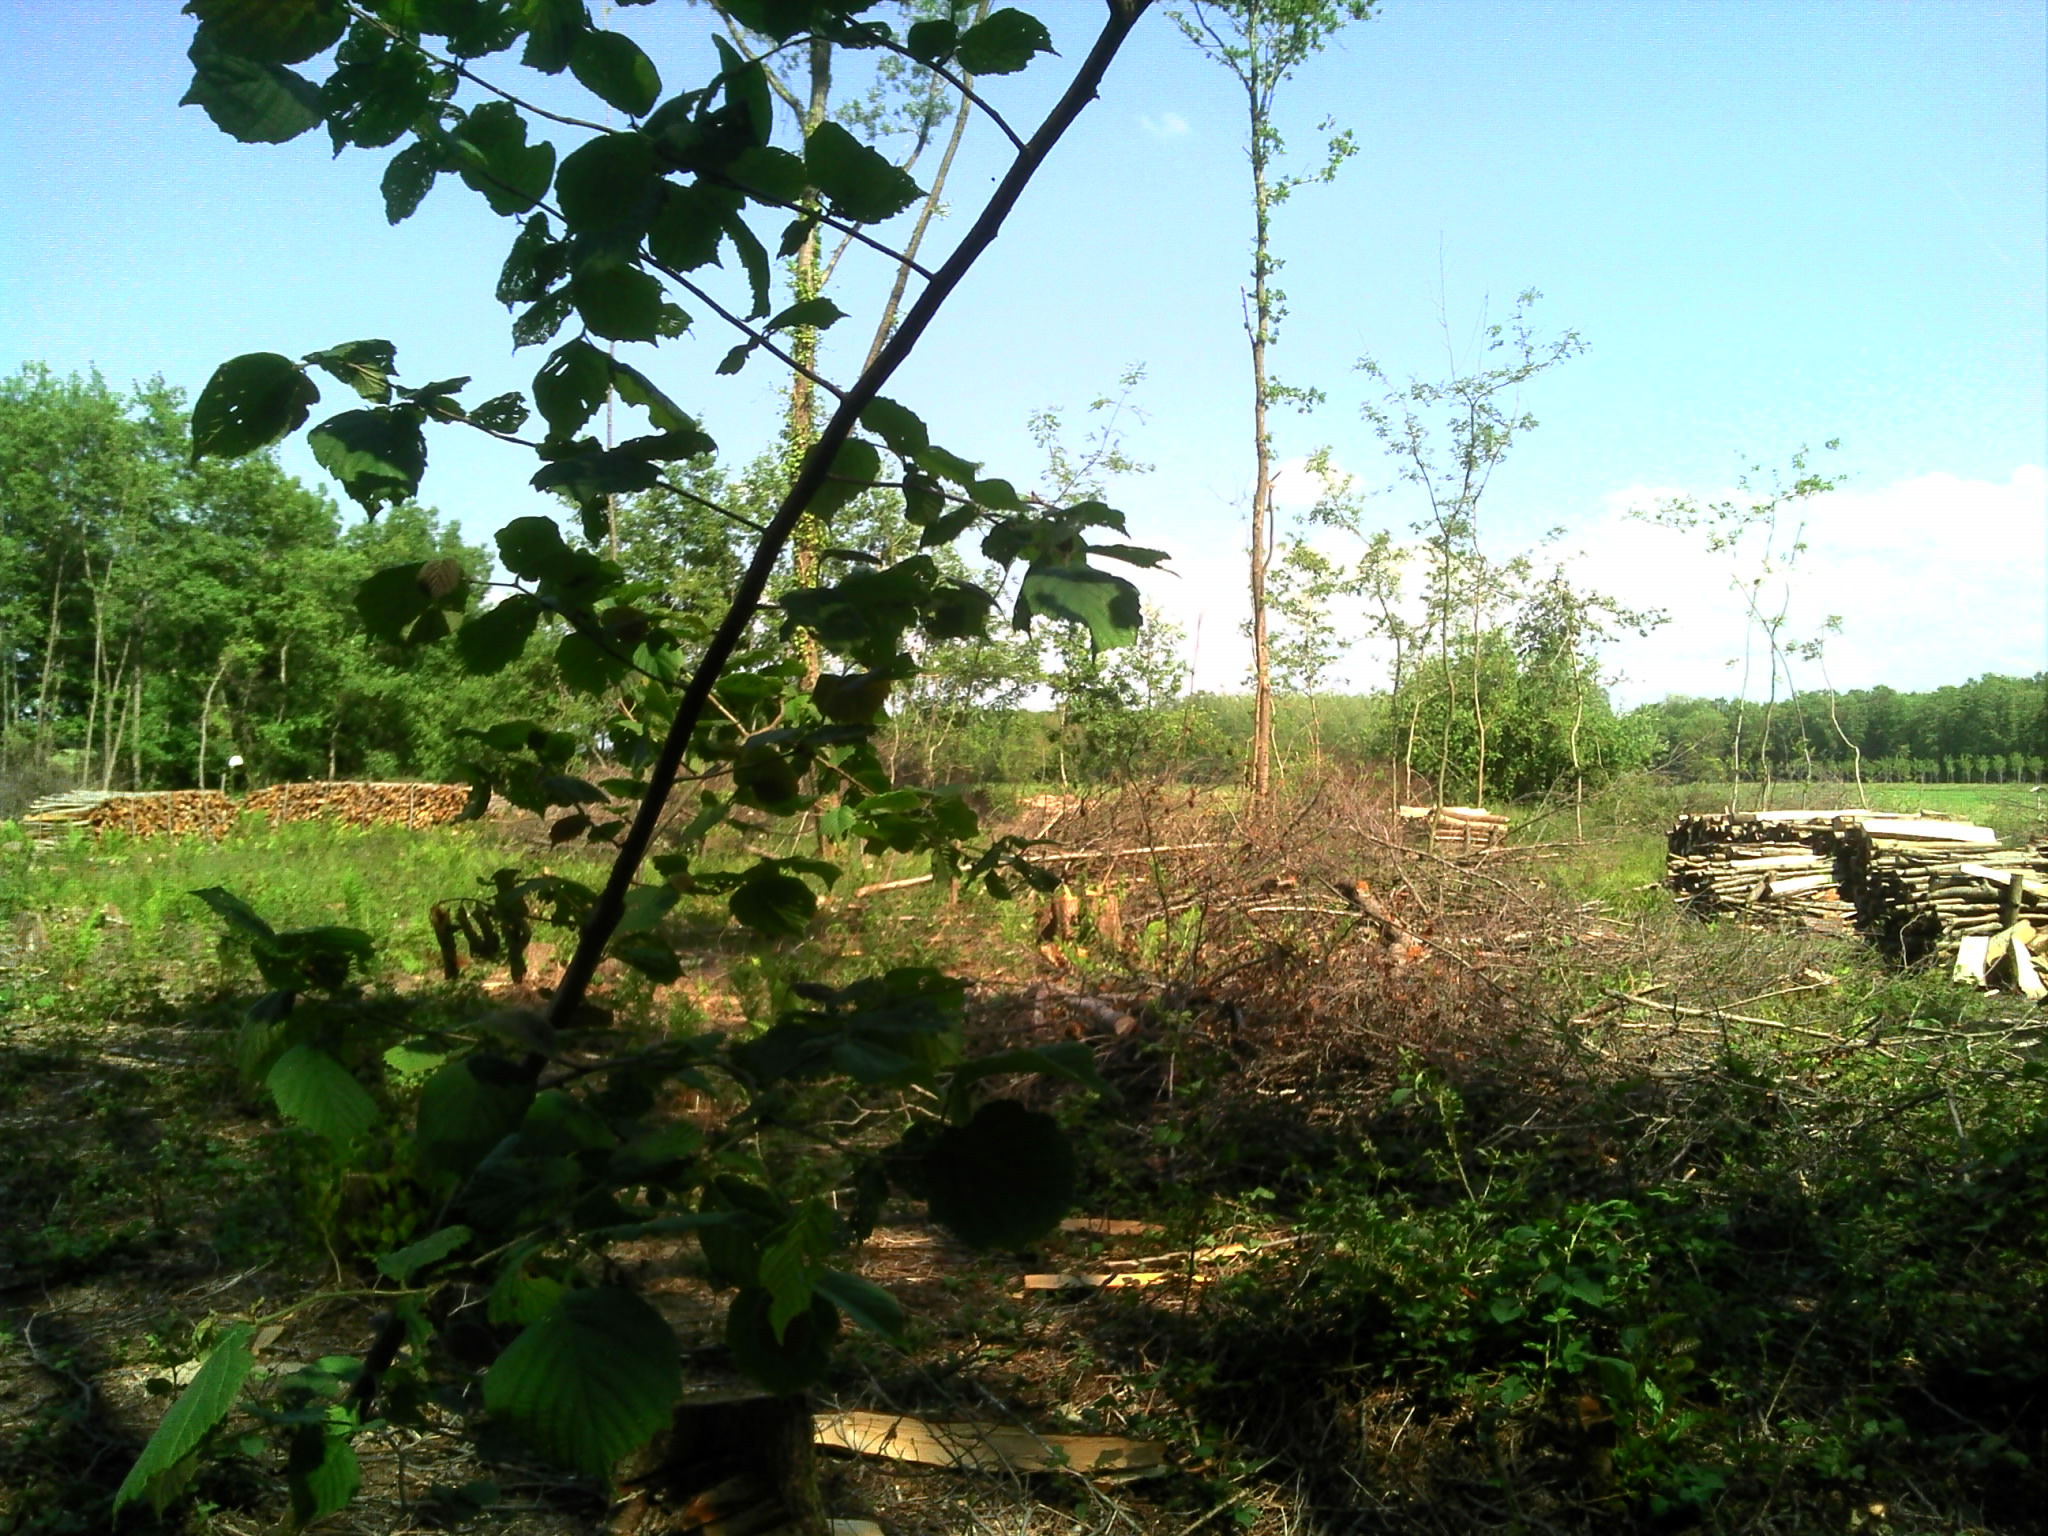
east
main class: Shrubland
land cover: Shrubland with sparse tree cover
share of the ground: 50 - 75 %
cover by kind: shrubs 60 %, herbaceous plants 20 %, consolidated bare surface 10 %, broadleaved forest trees 5 %, lichens and mosses 5 %
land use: Forestry
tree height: > 5 m
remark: Clear cut
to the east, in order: Ditches and canals; Shrubland with sparse tree cover; Spontaneously vegetated surfaces; Grass margins; Paved roads, cycling and walking lanes; Grass margins; Ditches and canals; Maize
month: May
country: FR
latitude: 46.5222
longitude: 4.9833
